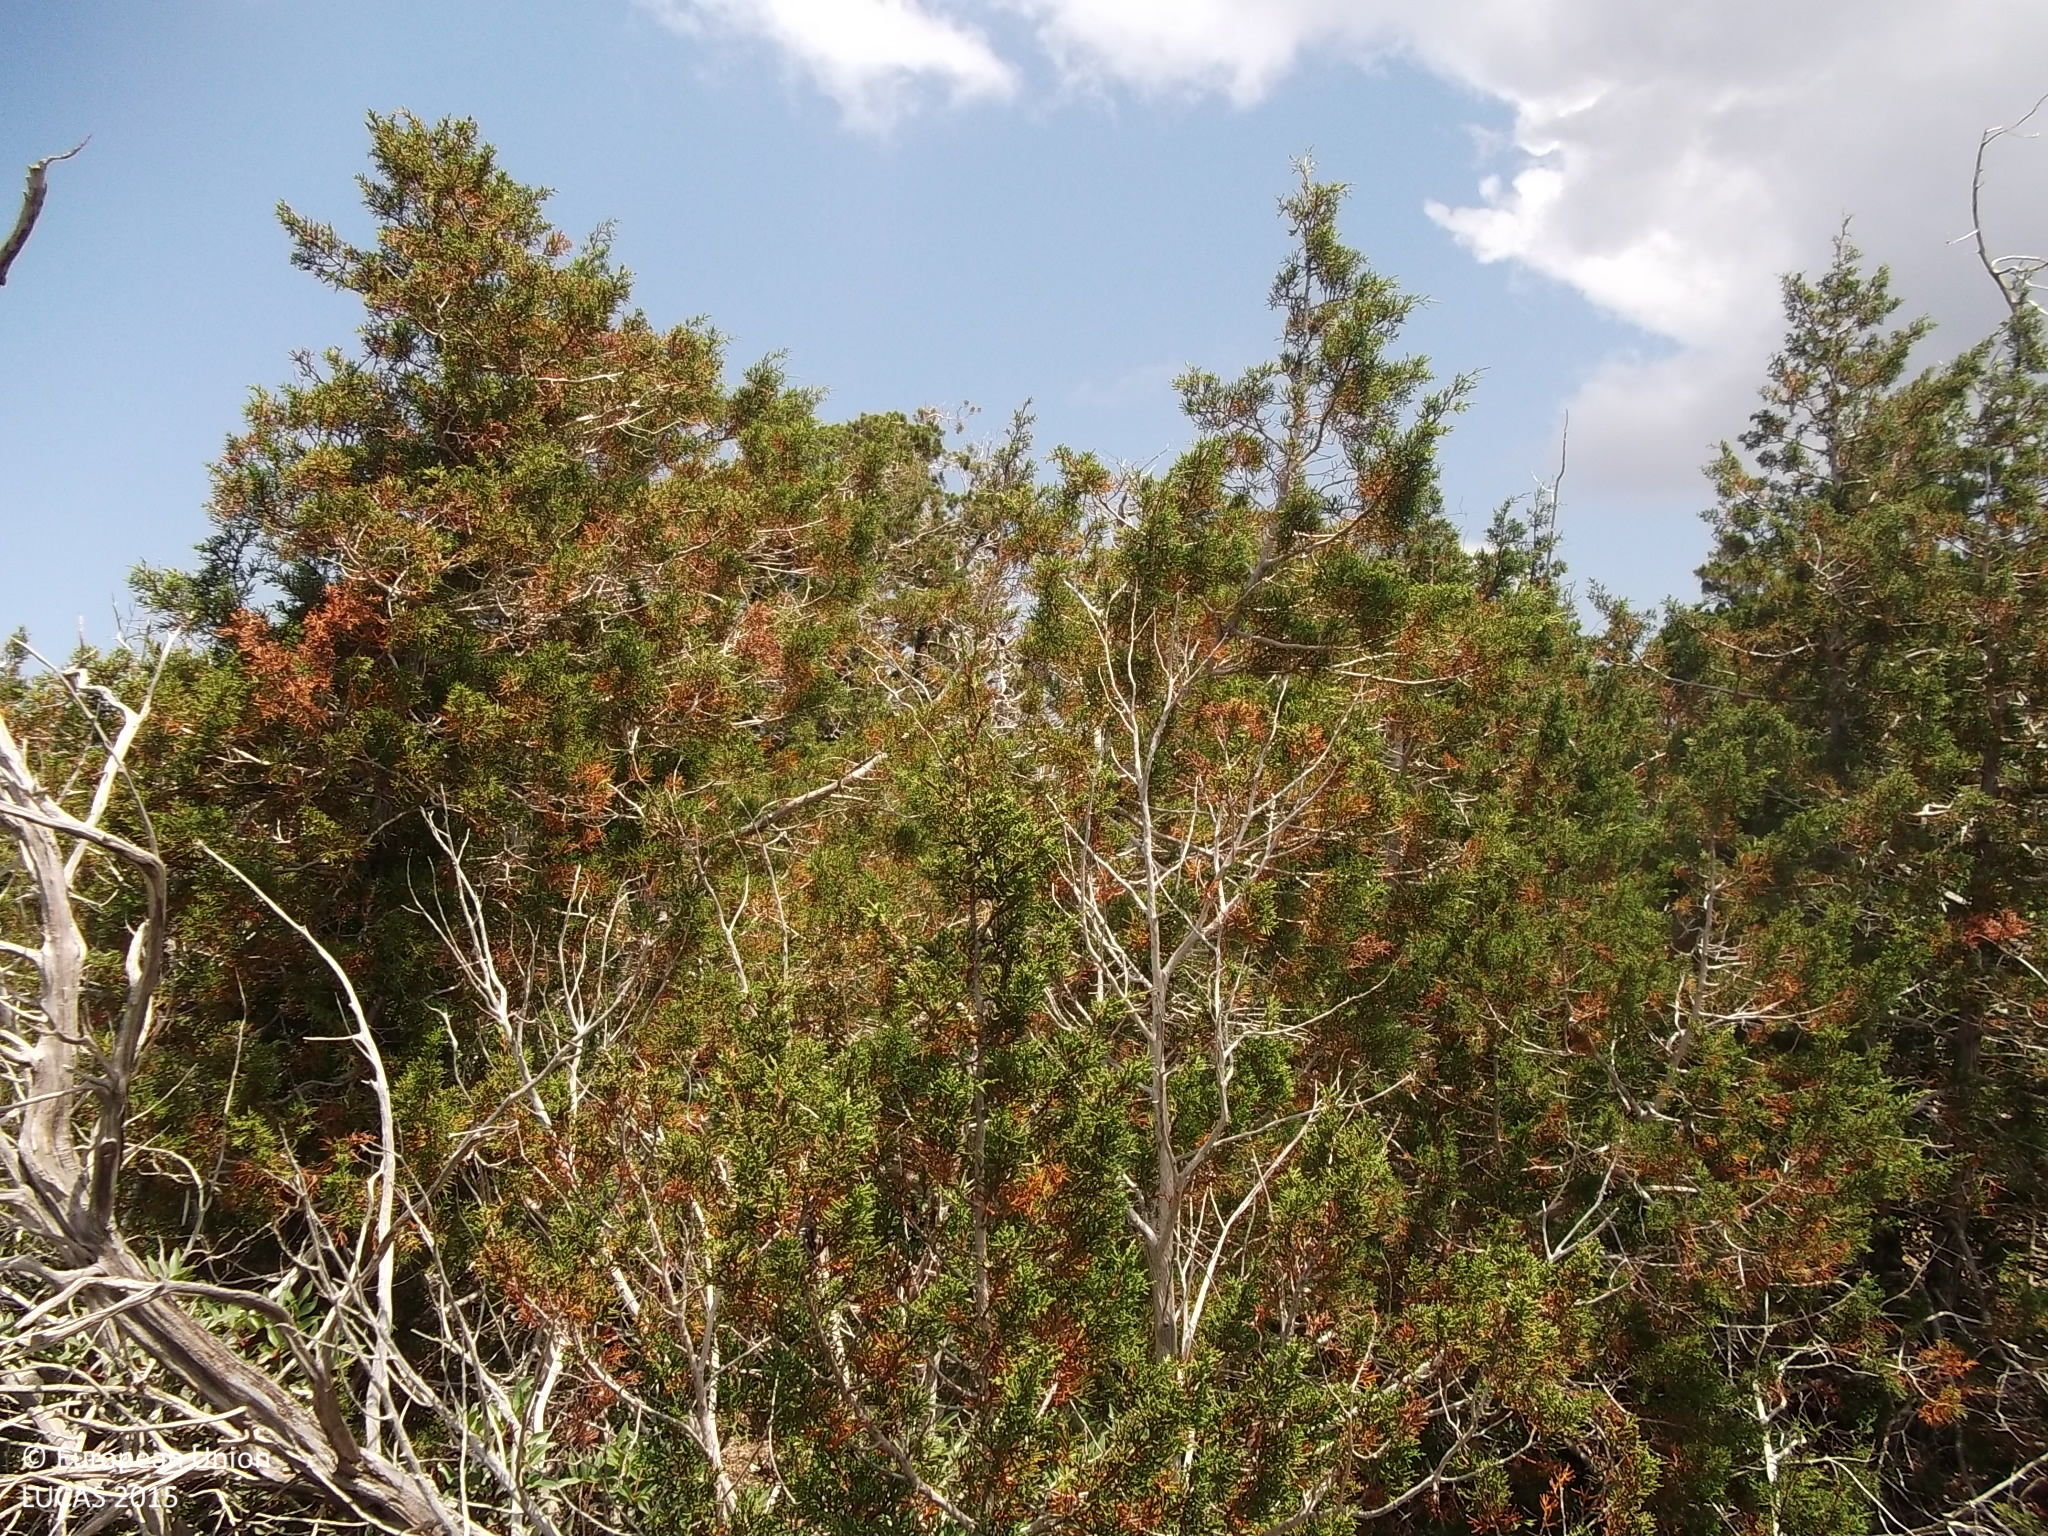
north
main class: Woodland
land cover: Other coniferous woodland
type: coniferous forest of the mediterranean region
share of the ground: > 75 %
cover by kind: coniferous forest trees 100 %
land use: Forestry
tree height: > 5 m
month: May
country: CY
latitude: 35.0490
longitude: 32.2835
